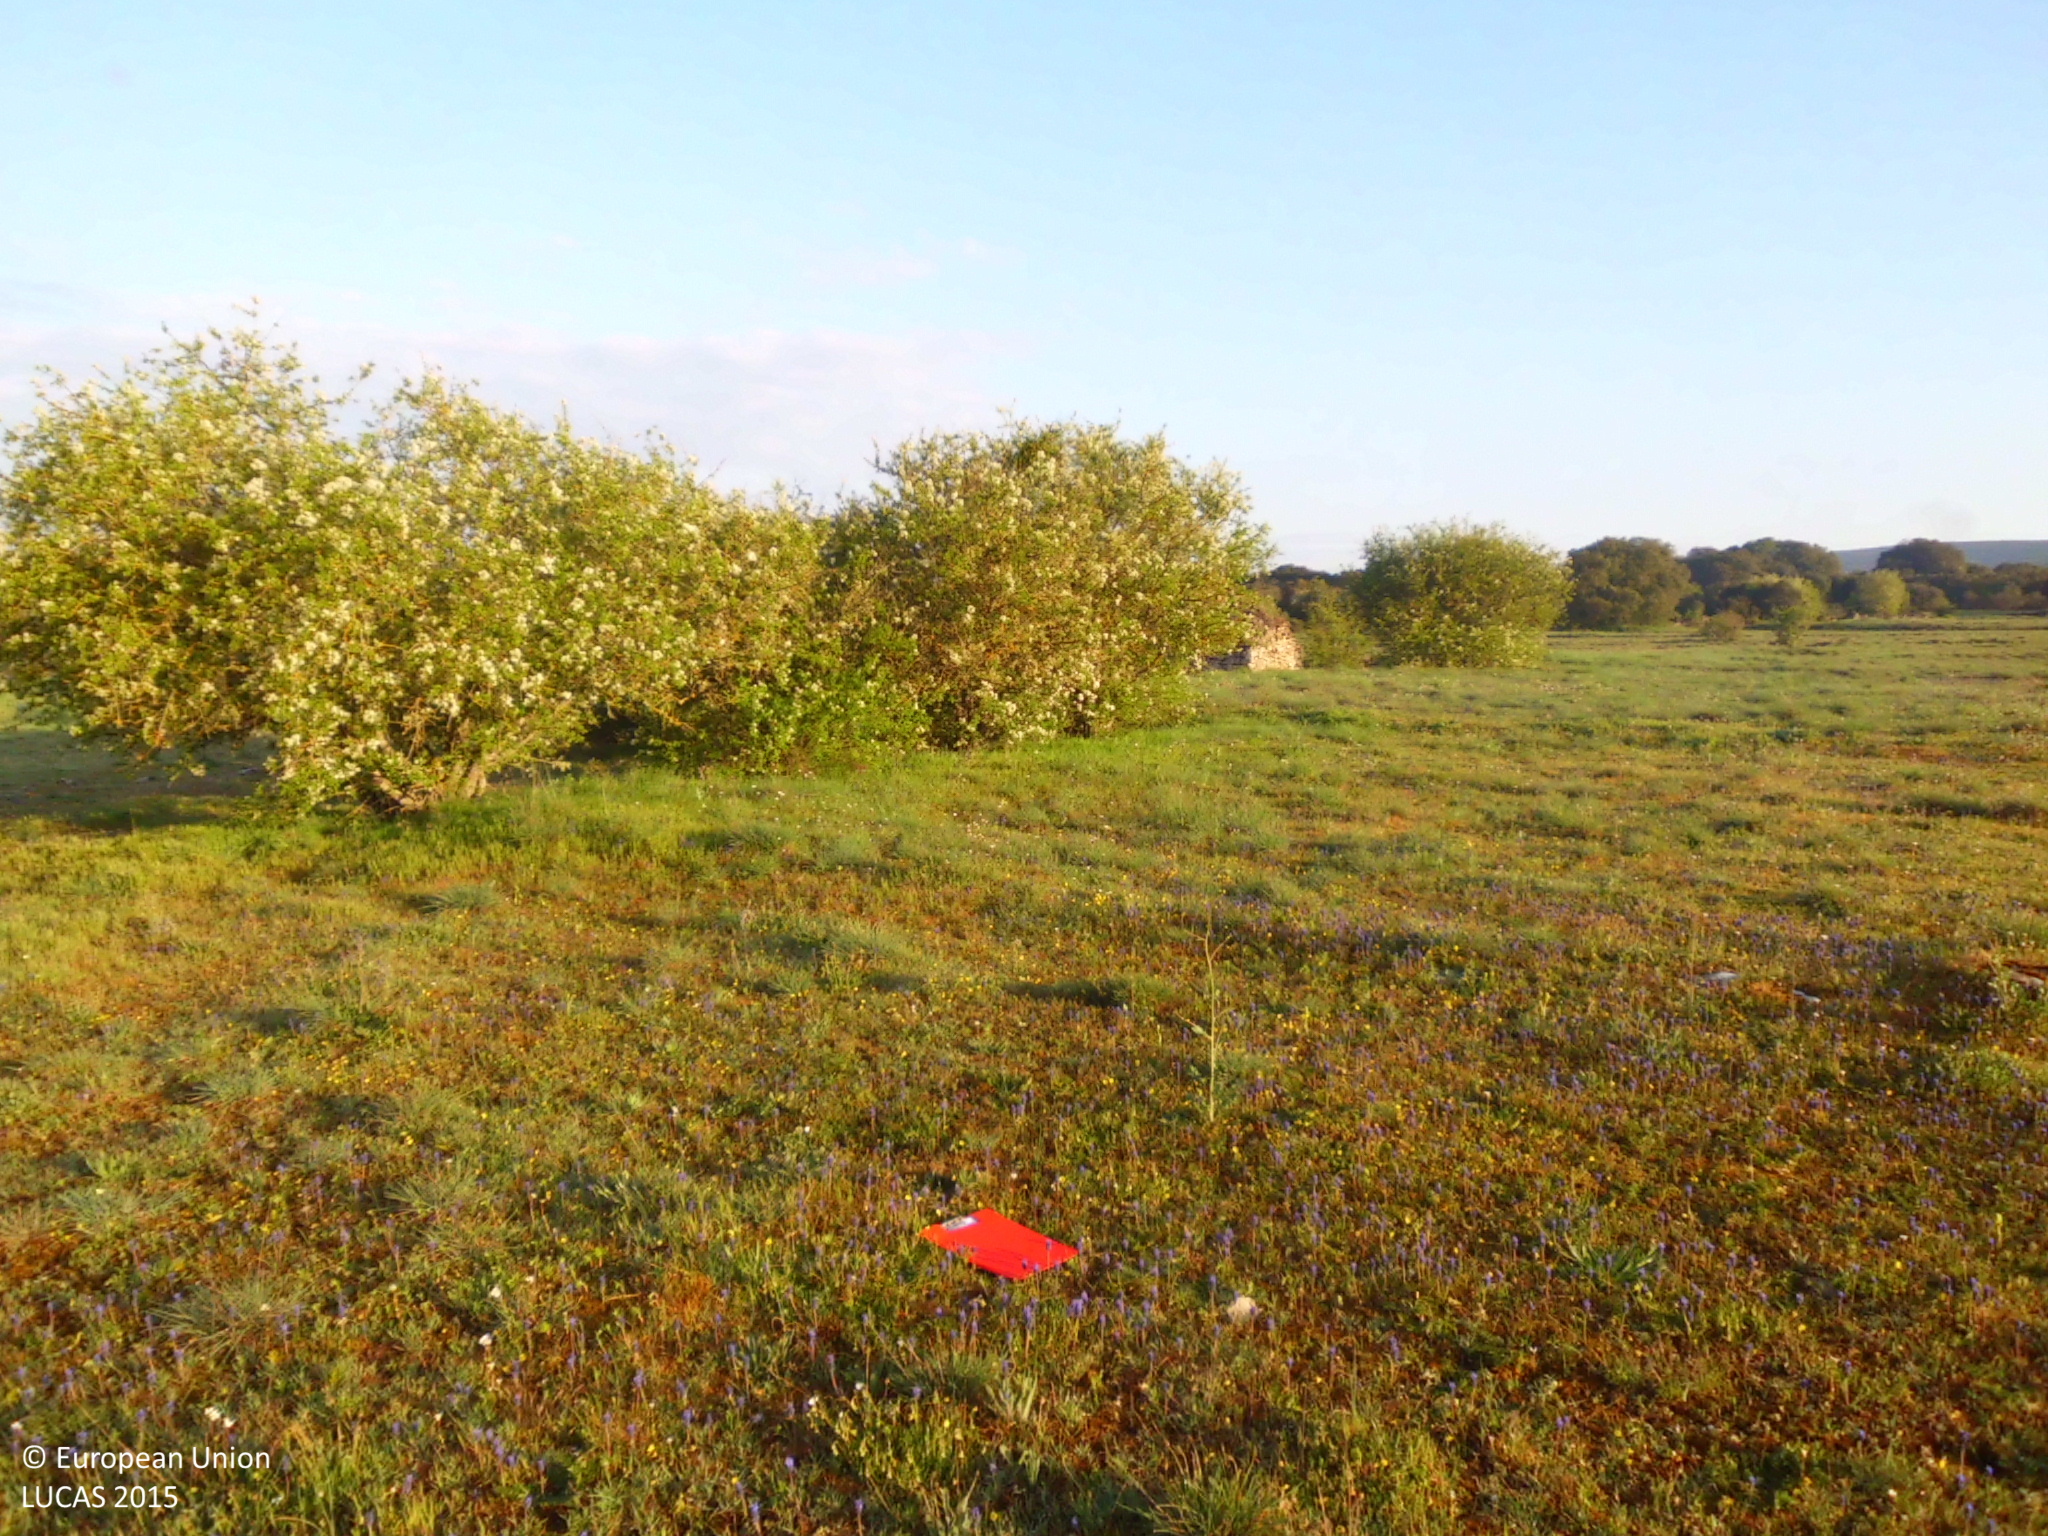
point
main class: Grassland
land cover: Grassland without tree/shrub cover
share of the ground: > 75 %
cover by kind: herbaceous plants 95 %, shrubs 5 %
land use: Abandoned areas
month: April
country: ES
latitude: 42.8407
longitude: -3.7828
